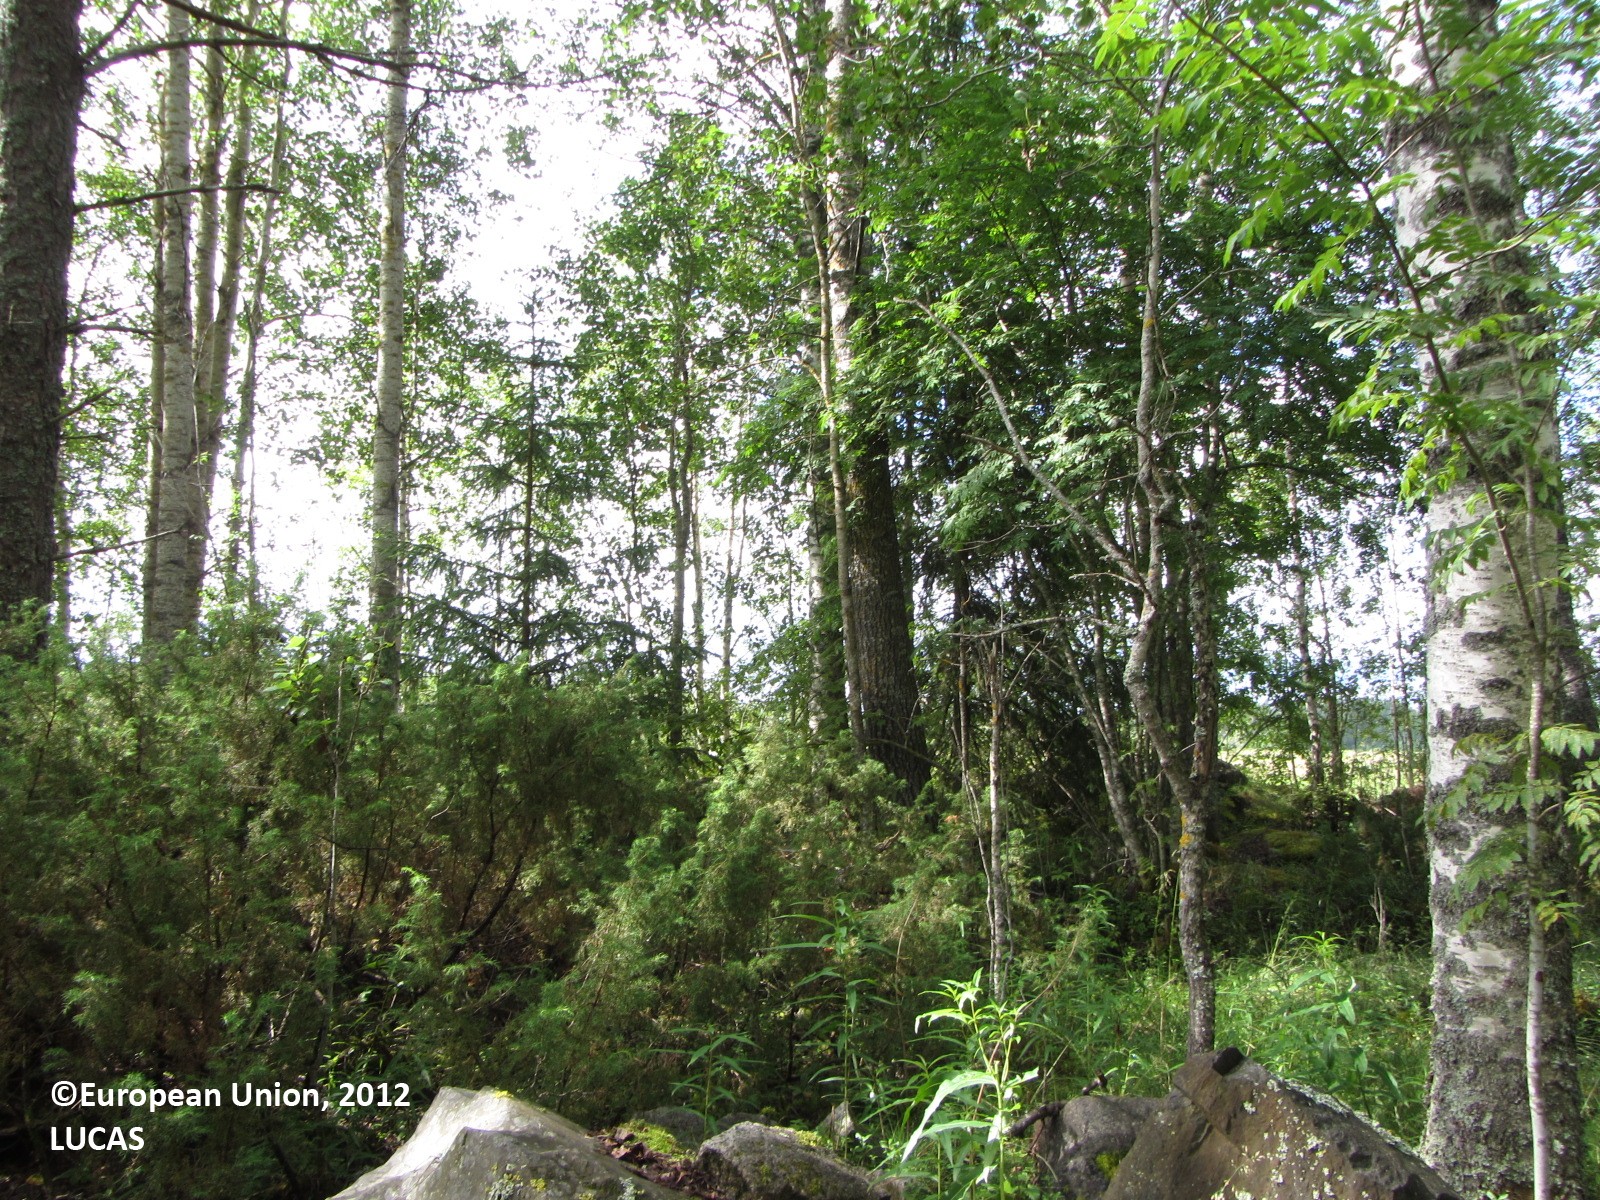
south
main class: Woodland
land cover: Broadleaved woodland
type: boreal forest
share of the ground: 50 - 75 %
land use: Forestry
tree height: > 5 m
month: July
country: FI
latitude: 63.8591
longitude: 24.6657
